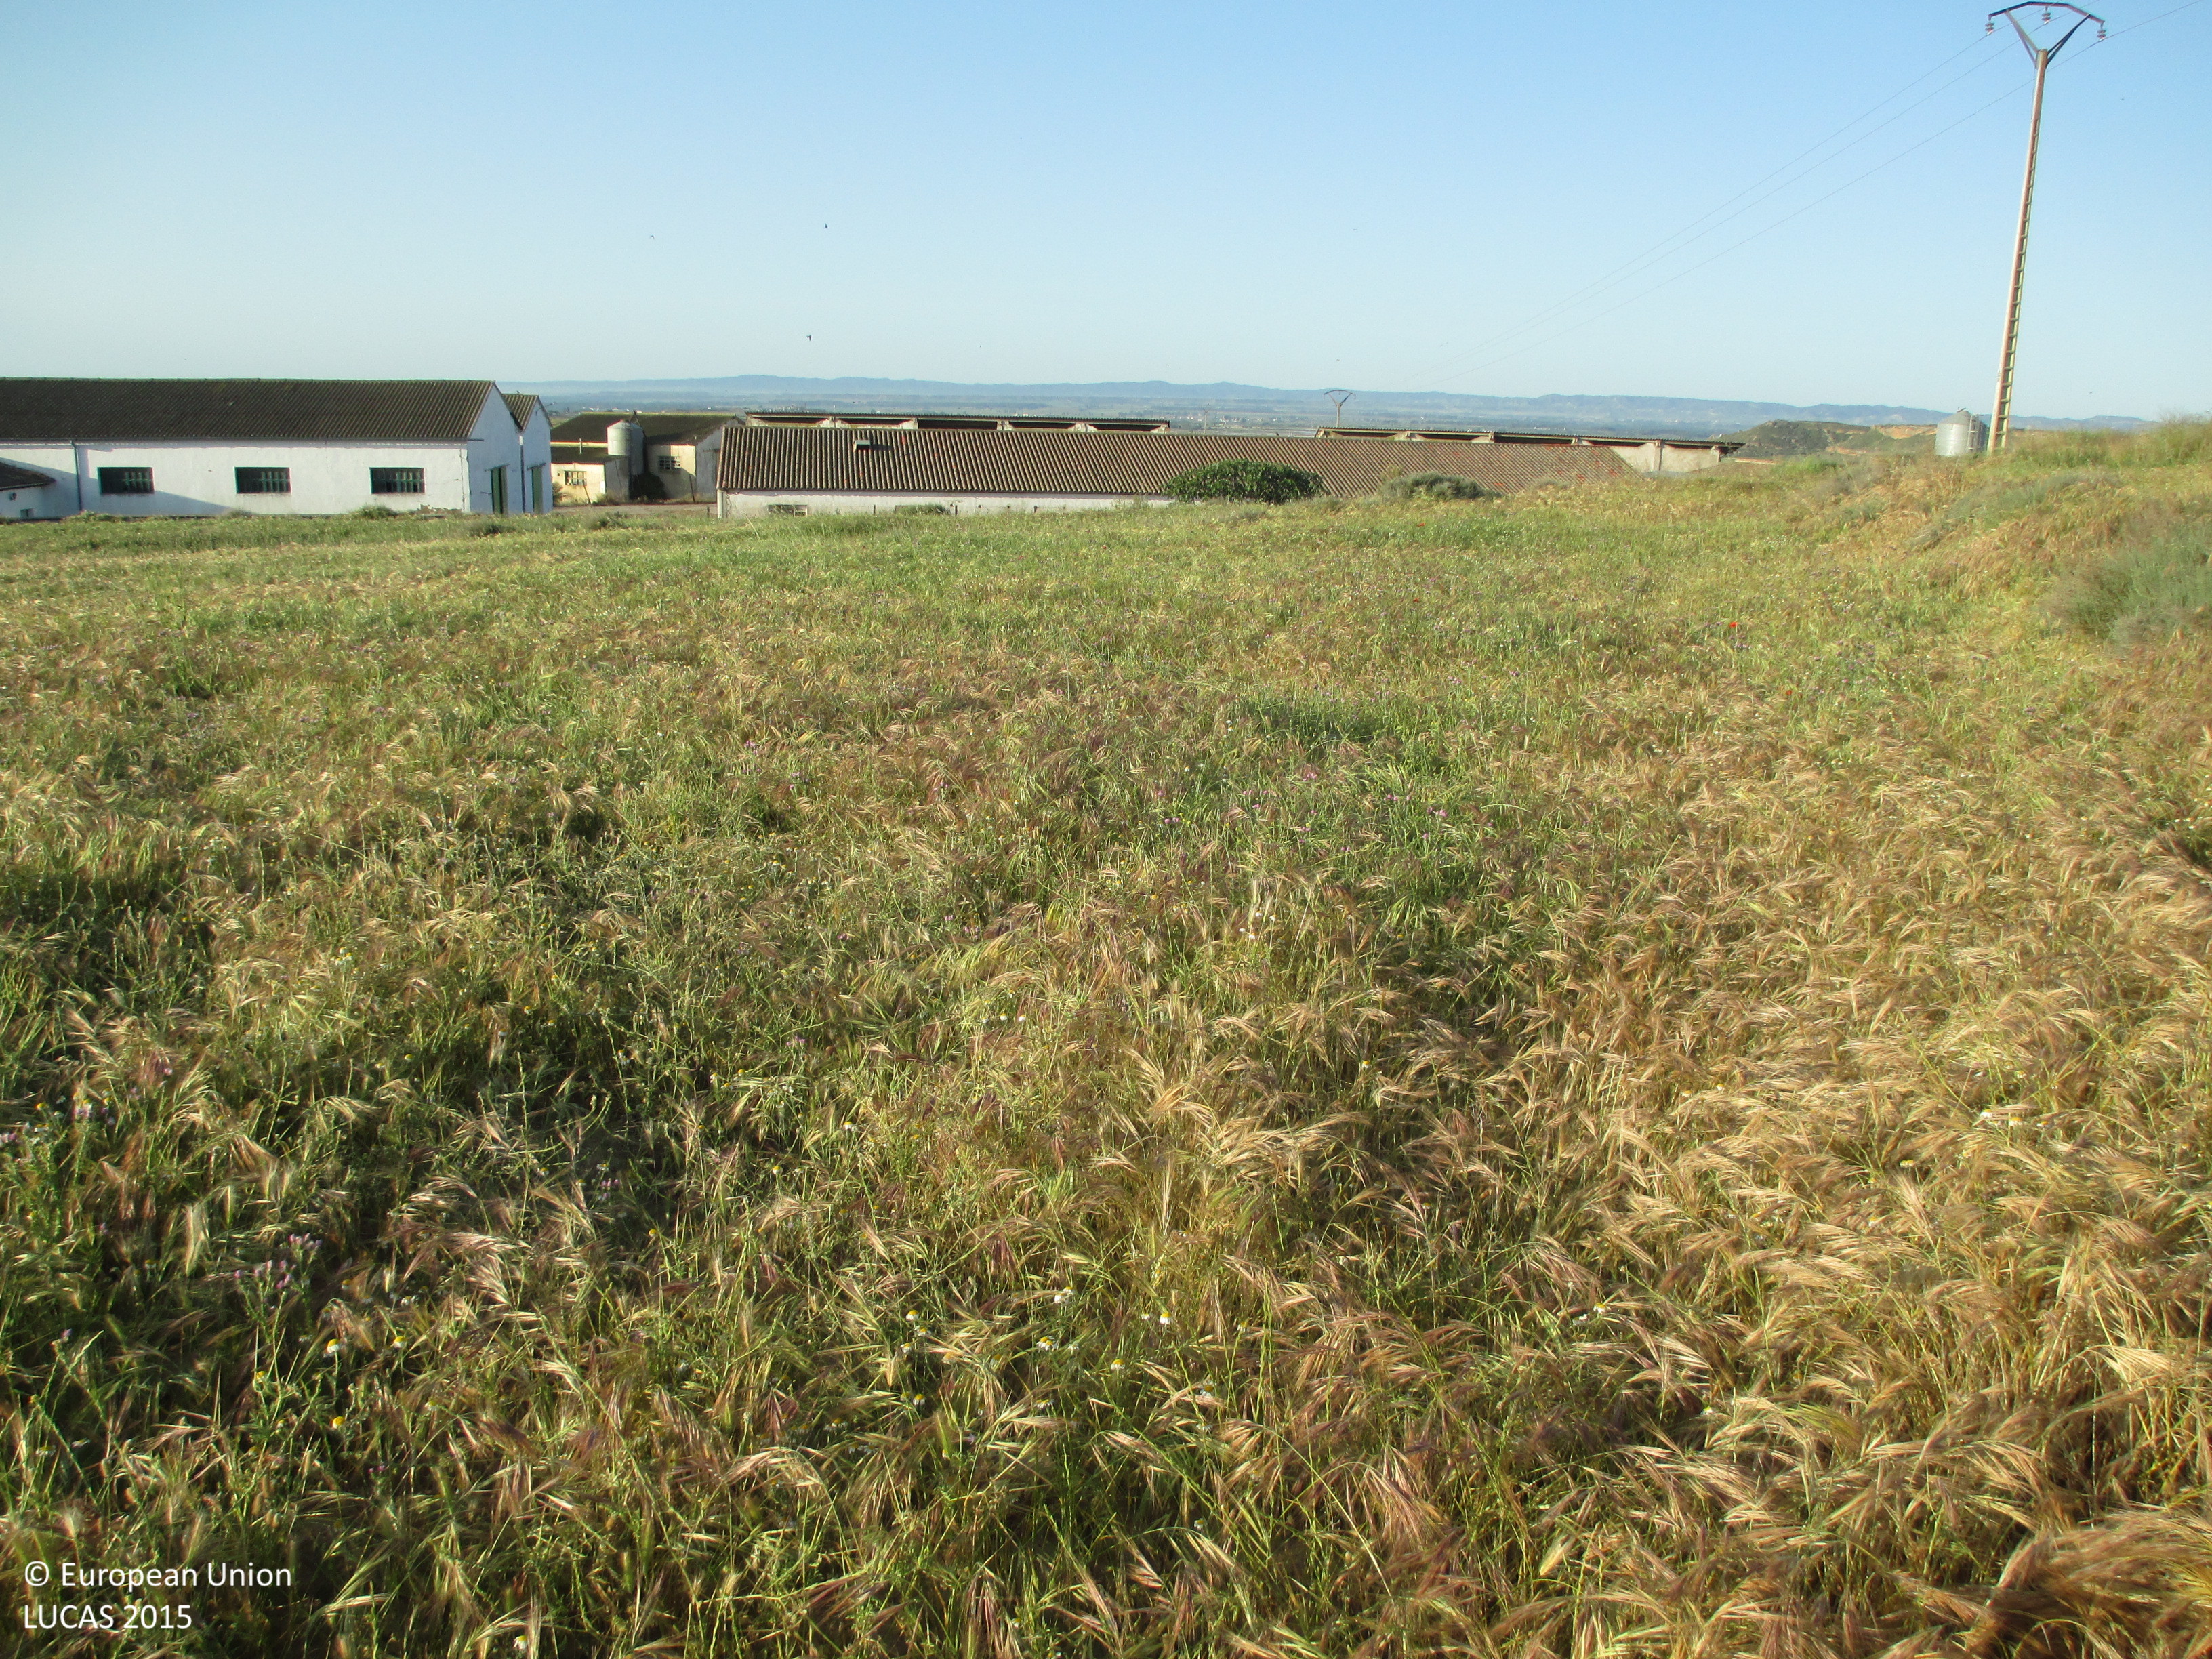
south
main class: Grassland
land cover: Spontaneously vegetated surfaces
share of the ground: > 75 %
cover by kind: herbaceous plants 100 %
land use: Fallow land
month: May
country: ES
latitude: 41.9933
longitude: -0.3664
